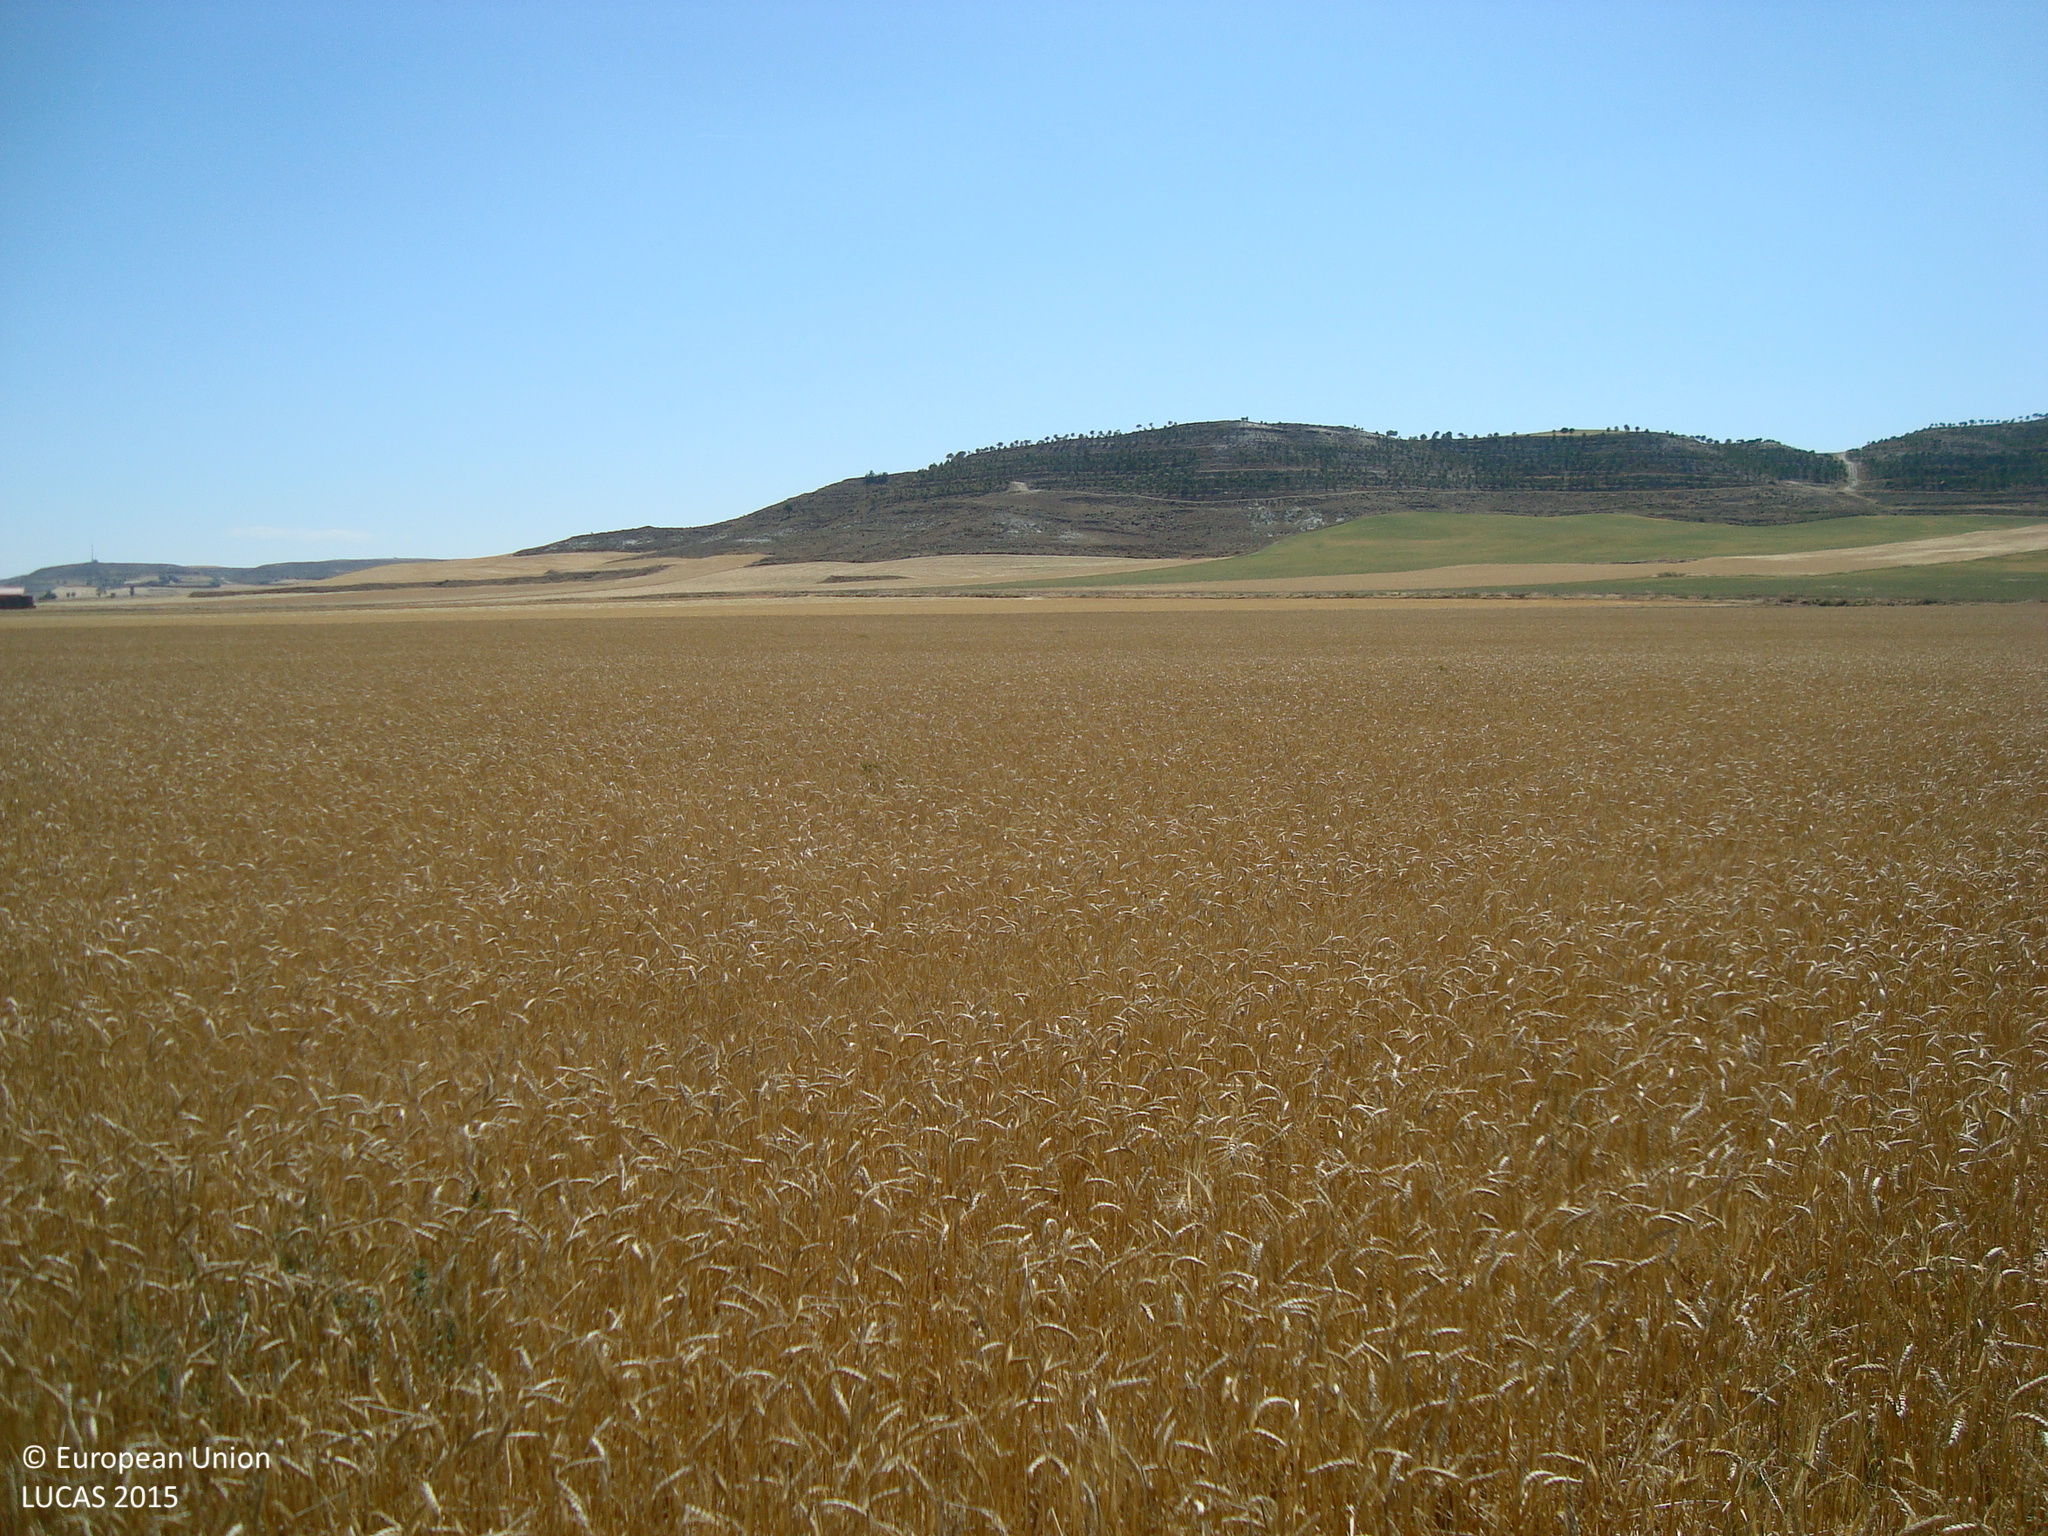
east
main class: Cropland
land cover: Common wheat
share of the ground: > 75 %
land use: Agriculture (excluding fallow land and kitchen gardens)
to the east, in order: Common wheat; Other bare soil; Barley
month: July
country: ES
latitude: 42.0453
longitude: -4.2371
